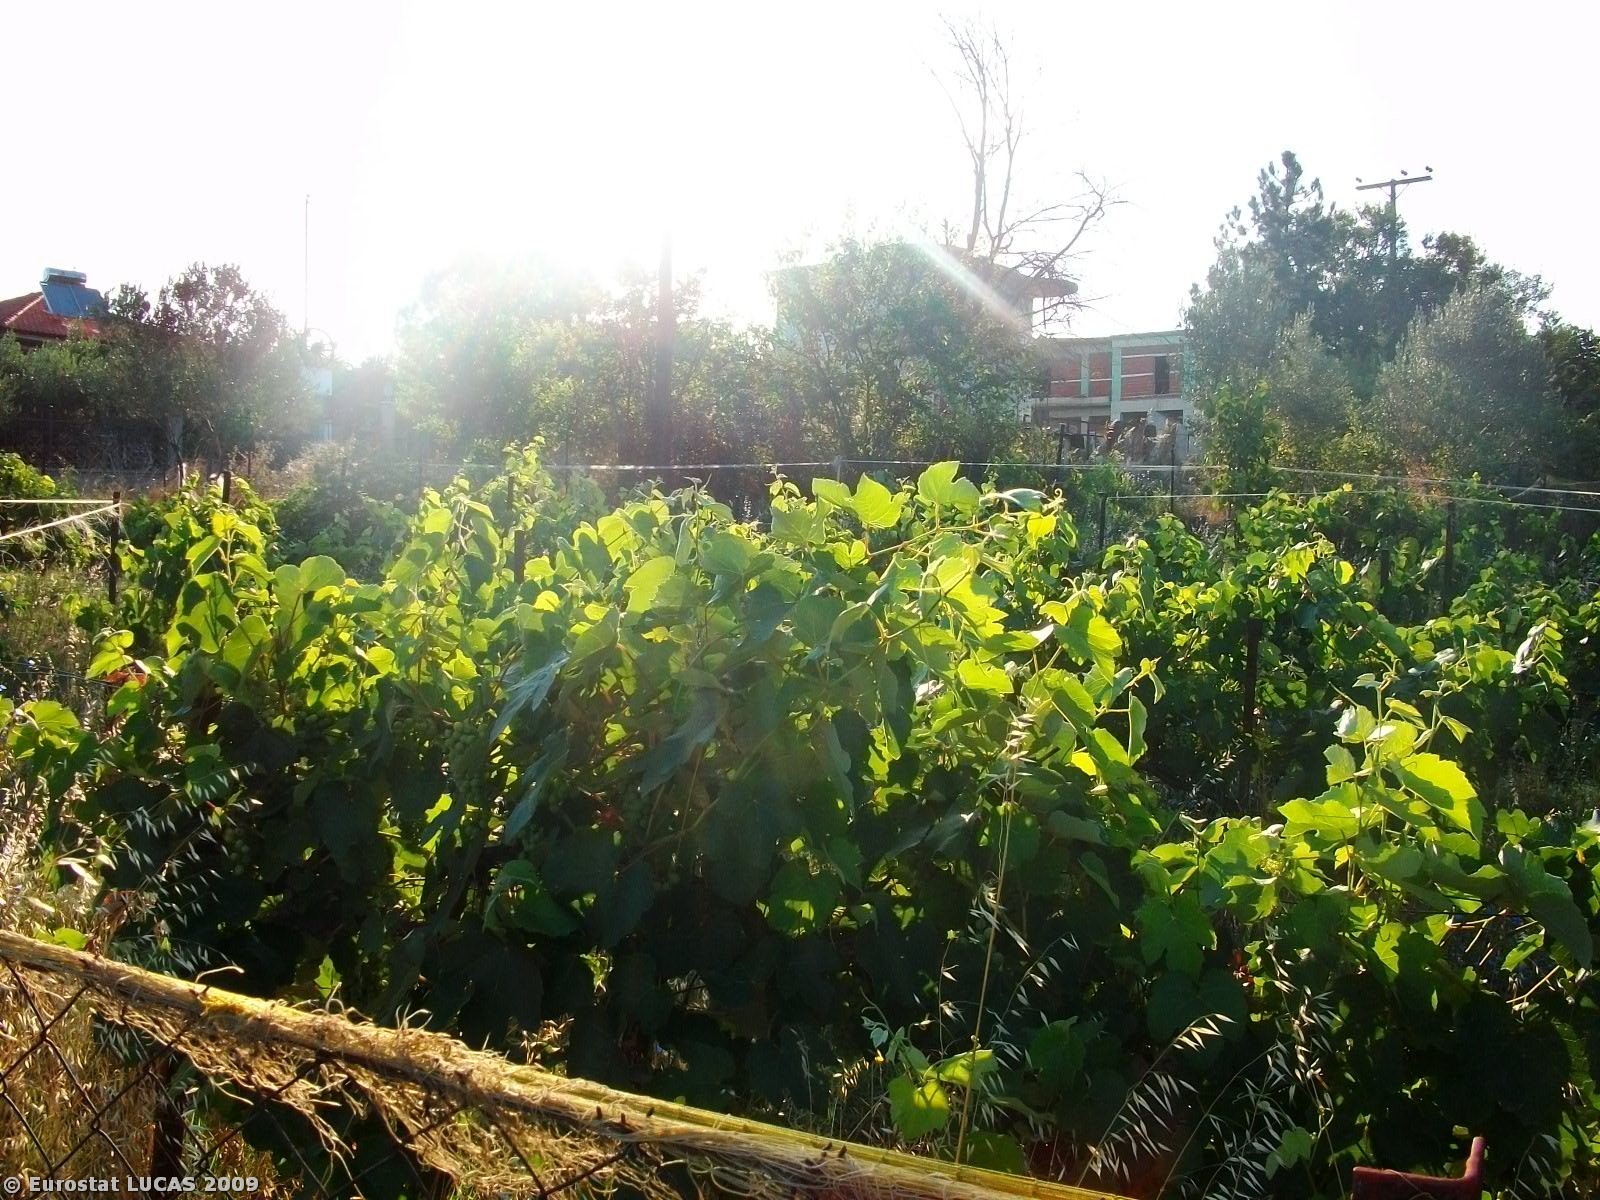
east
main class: Cropland
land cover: Vineyards
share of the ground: 50 - 75 %
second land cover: Grassland with sparse tree/shrub cover
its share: > 75 %
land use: Agriculture (excluding fallow land and kitchen gardens)
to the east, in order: Vineyards; Grassland with sparse tree/shrub cover; Fences; Abandoned hedges; Electric lines; Grass margins; Paved roads, cycling and walking lanes; Grass margins; Fences; Olive groves; Grassland with sparse tree/shrub cover; Coniferous woodland; Electric lines; Artificial constructions in urban areas; Shrubland with sparse tree cover; Fences; Grass margins; Paved roads, cycling and walking lanes; Grass margins; Fences; Olive groves; Grassland with sparse tree/shrub cover; Fences; Grass margins; Paved roads, cycling and walking lanes; Grass margins; Broadleaved woodland; Grassland with sparse tree/shrub cover
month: July
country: GR
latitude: 41.0139
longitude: 22.8166
